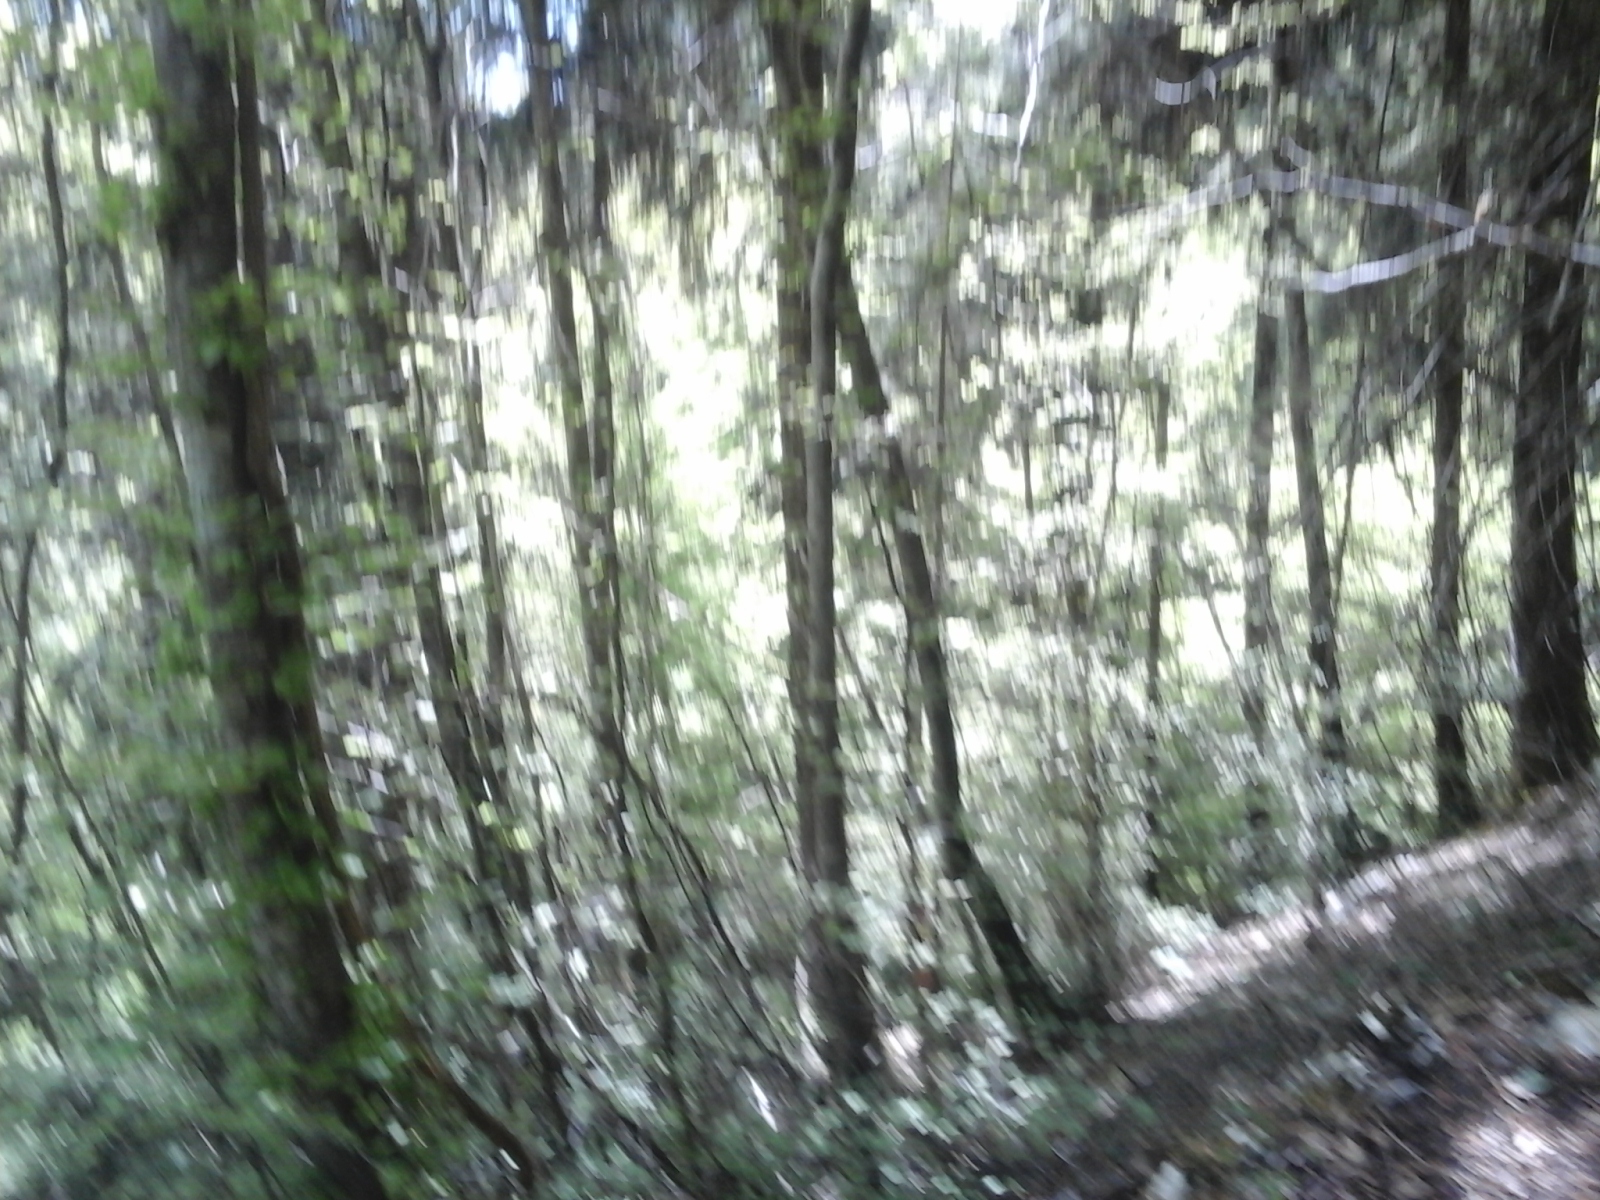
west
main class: Woodland
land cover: Spruce dominated mixed woodland
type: alpine coniferous forest
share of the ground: > 75 %
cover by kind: coniferous forest trees 75 %, broadleaved forest trees 25 %
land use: Forestry
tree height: > 5 m
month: May
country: IT
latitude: 45.8988
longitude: 10.6563
